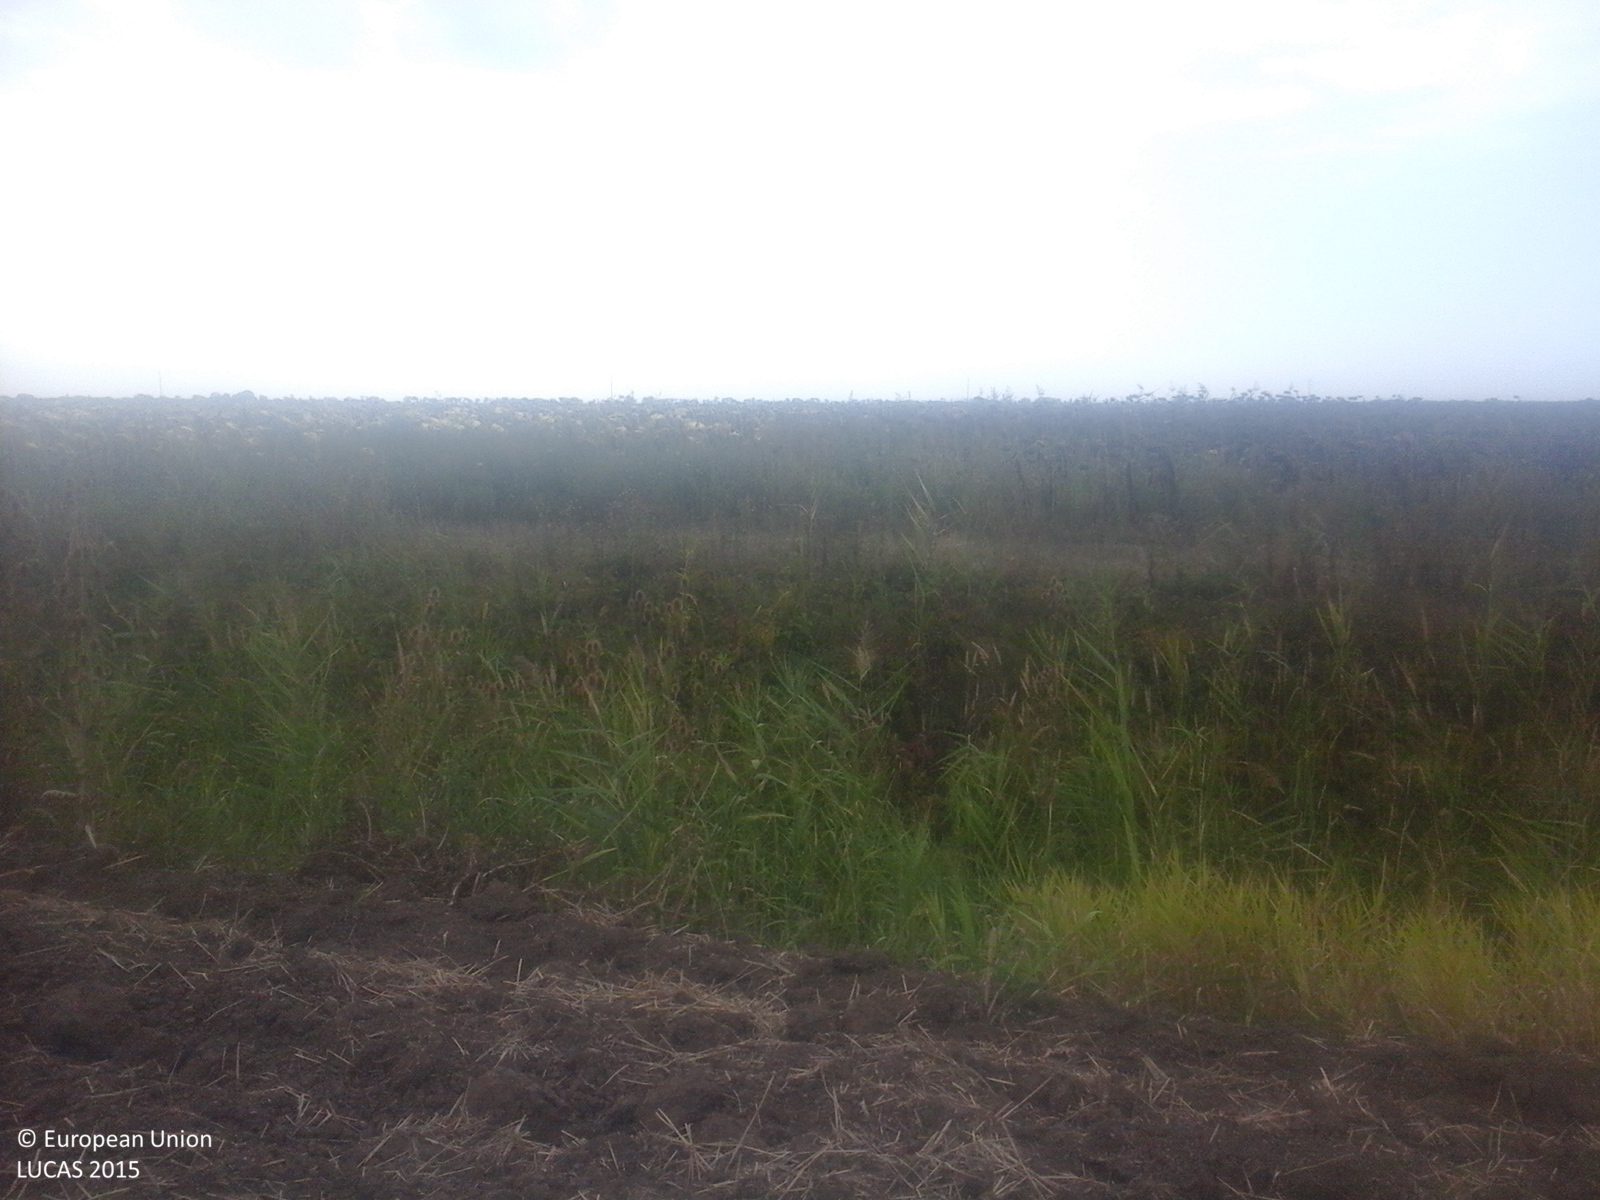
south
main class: Cropland
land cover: Common wheat
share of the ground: < 10 %
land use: Agriculture (excluding fallow land and kitchen gardens)
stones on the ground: < 10 %
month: September
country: RO
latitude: 47.7477
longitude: 22.6381
